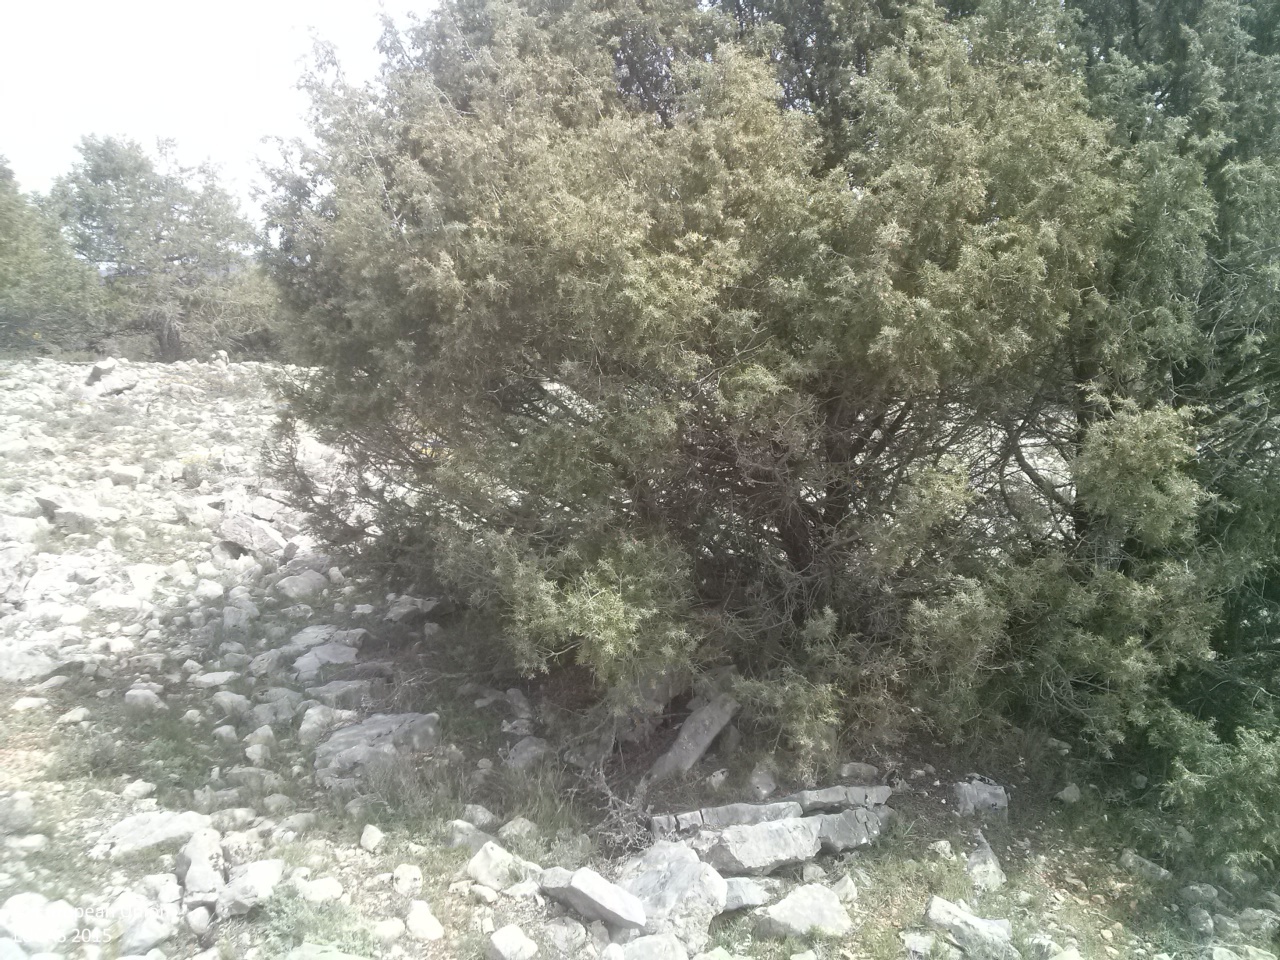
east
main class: Grassland
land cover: Grassland with sparse tree/shrub cover
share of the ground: 50 - 75 %
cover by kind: consolidated bare surface 55 %, herbaceous plants 35 %, coniferous forest trees 5 %, shrubs 5 %
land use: Semi-natural and natural areas not in use
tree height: < 5 m
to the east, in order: Grassland with sparse tree/shrub cover; Other coniferous woodland; Grassland with sparse tree/shrub cover
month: April
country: ES
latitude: 40.0561
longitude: -1.8651
